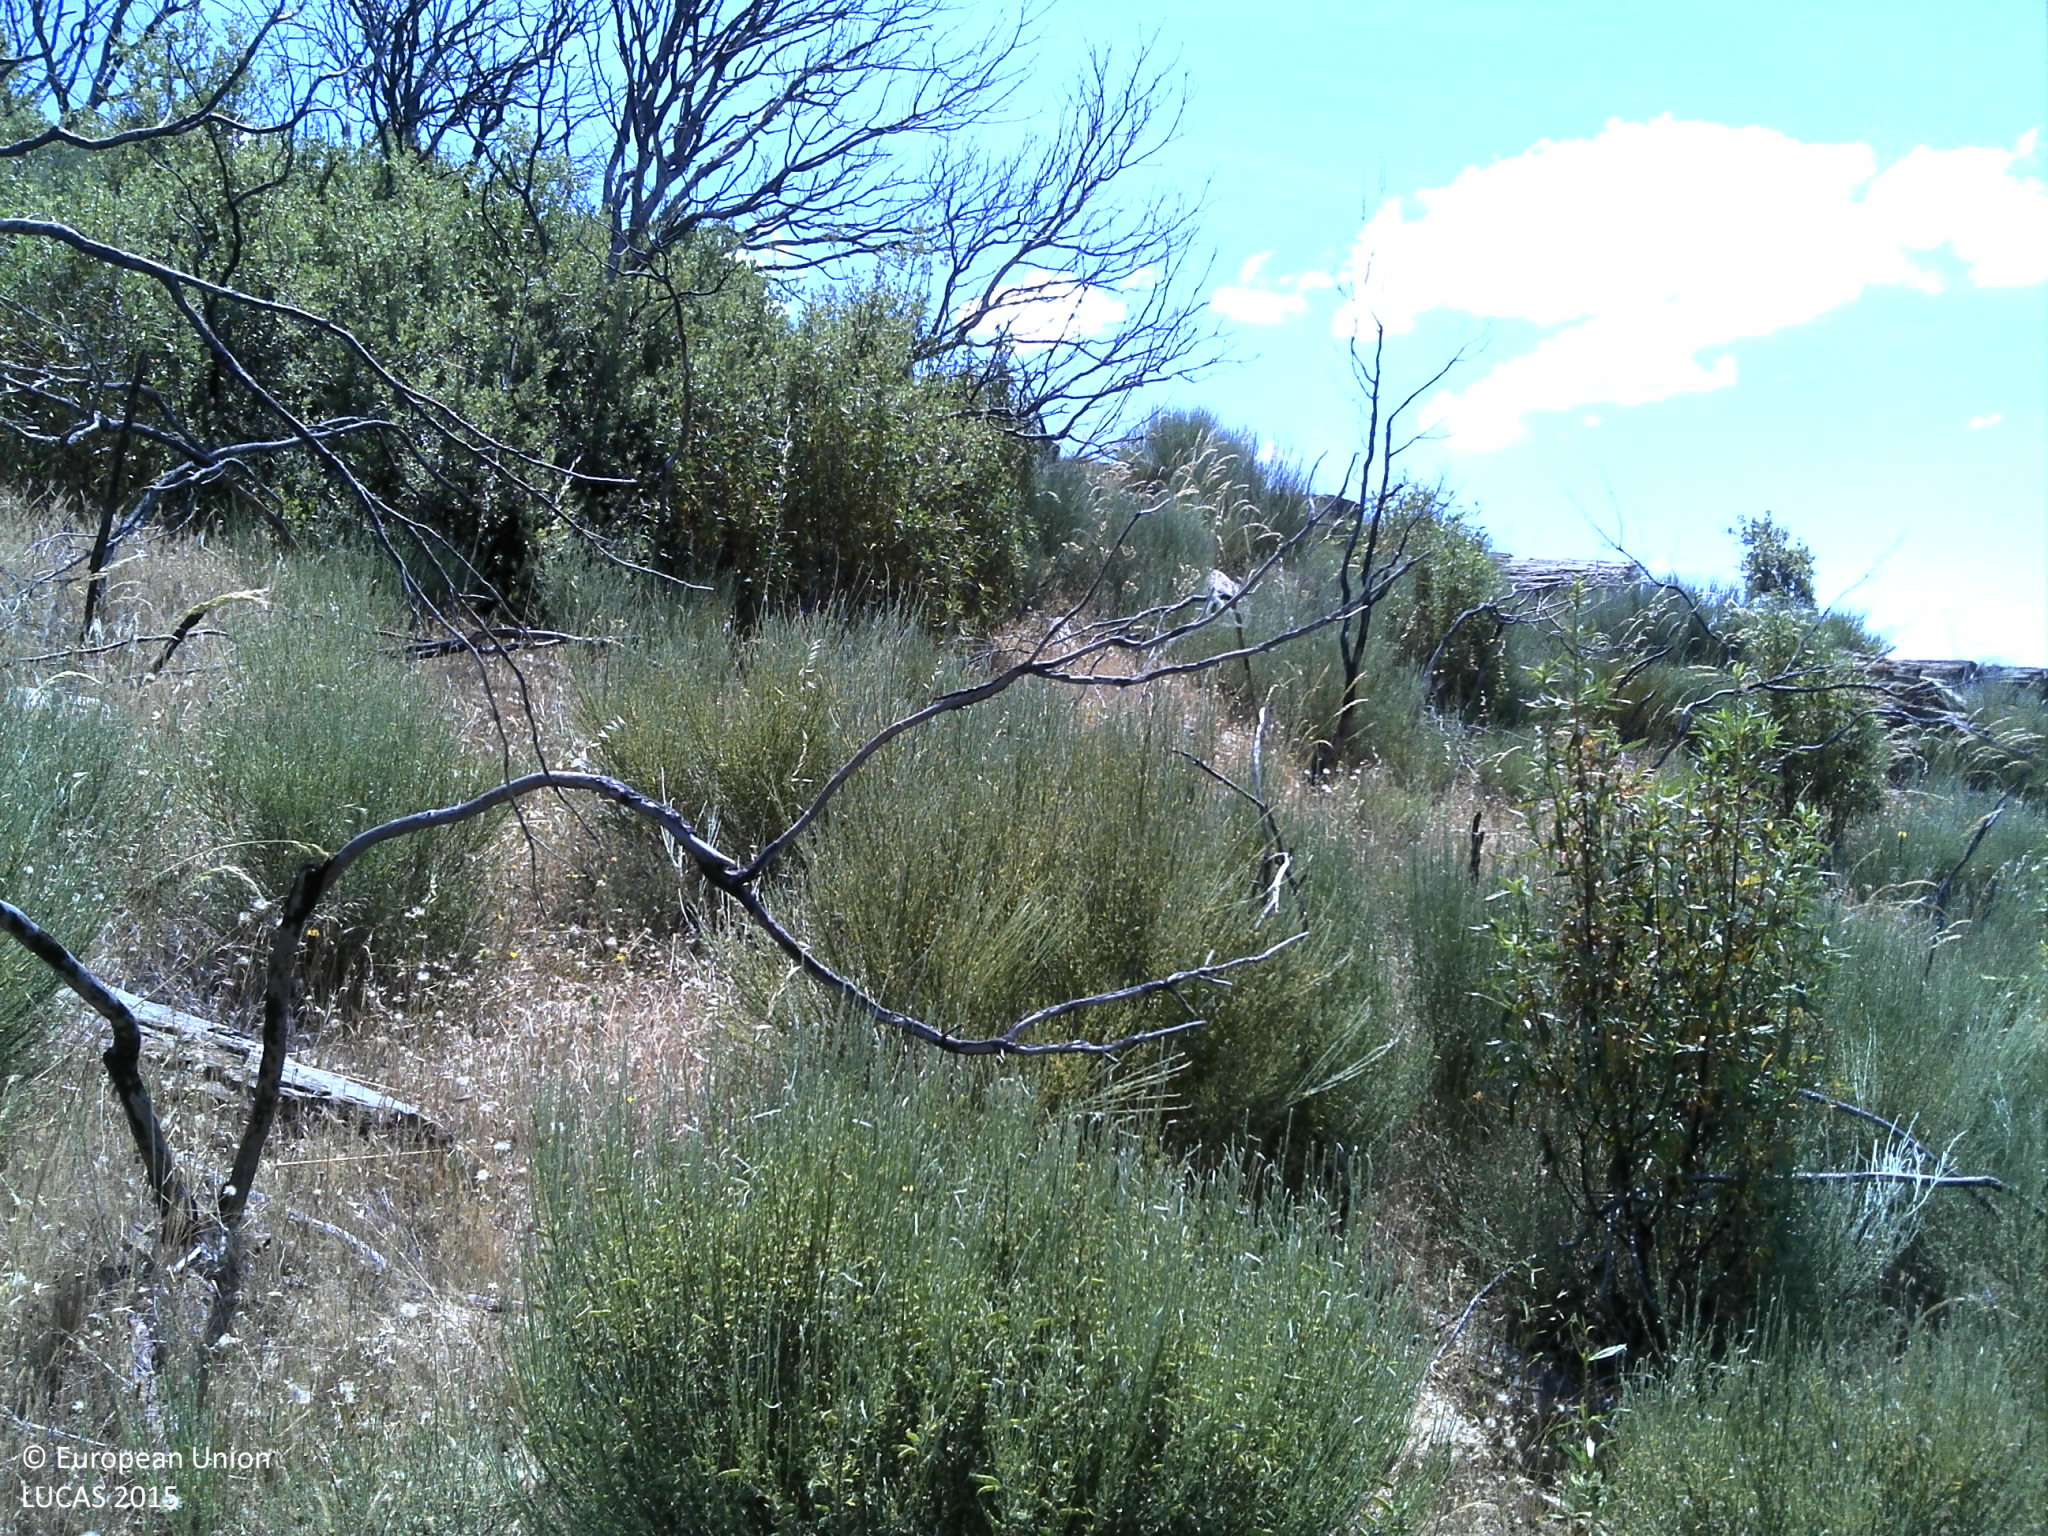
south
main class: Shrubland
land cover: Shrubland with sparse tree cover
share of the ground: 50 - 75 %
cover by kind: shrubs 75 %, herbaceous plants 10 %, unconsolidated bare surface 10 %, broadleaved forest trees 5 %
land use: Abandoned areas
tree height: < 5 m
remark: Burnt area
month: May
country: PT
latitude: 41.1409
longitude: -6.9420
